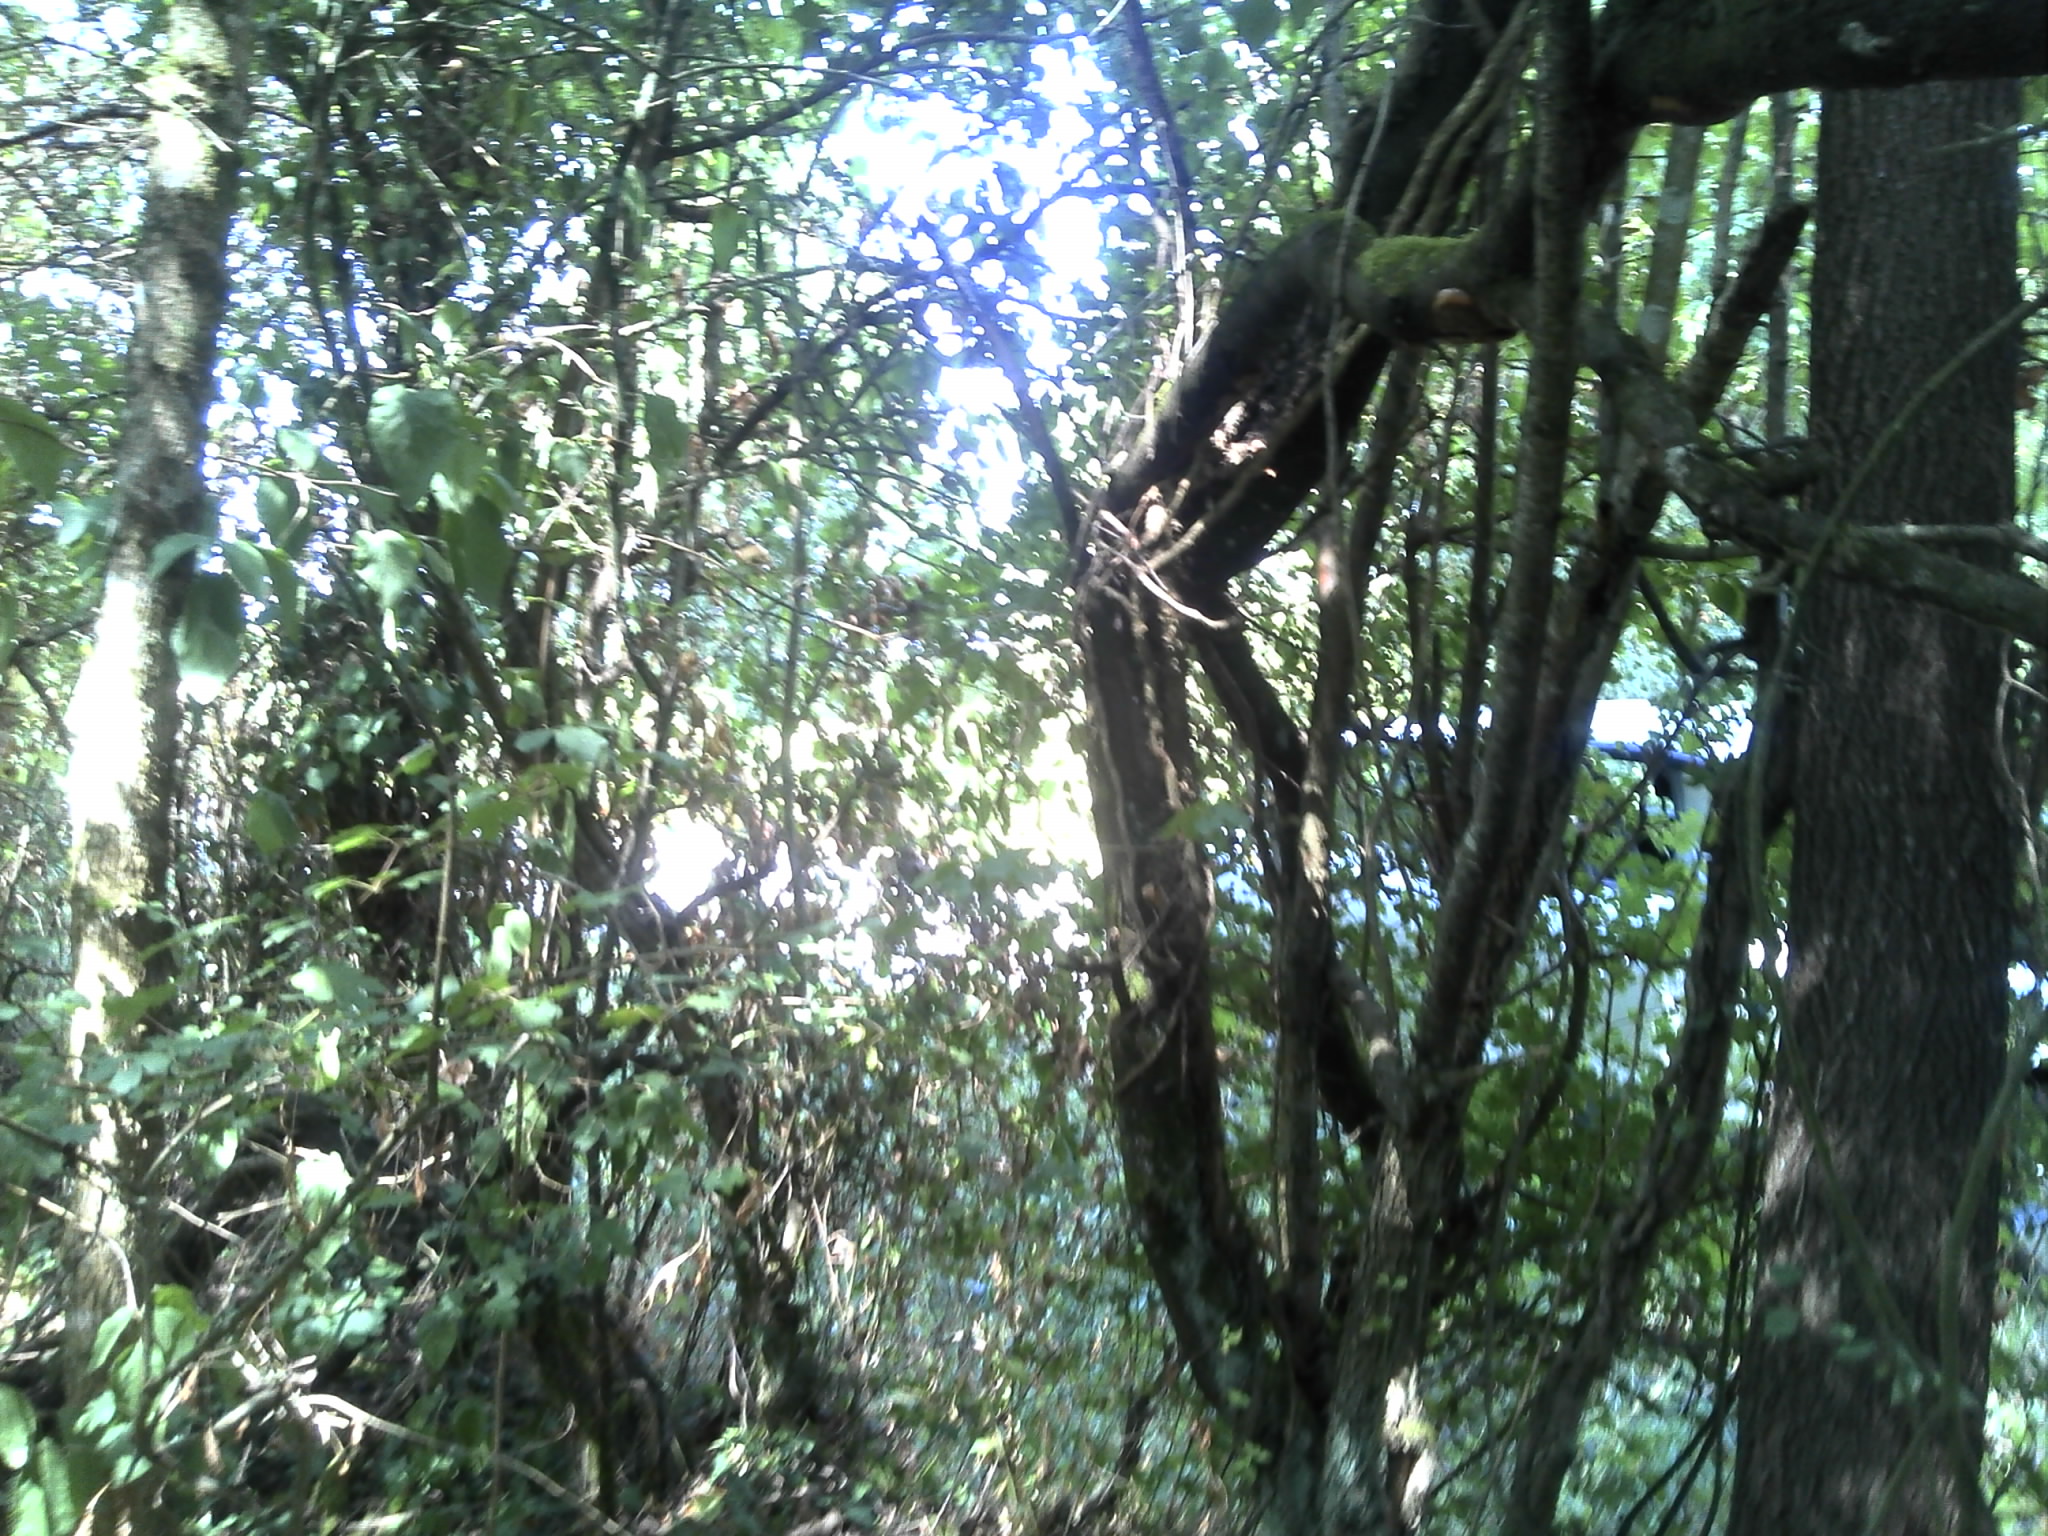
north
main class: Woodland
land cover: Broadleaved woodland
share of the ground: > 75 %
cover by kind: broadleaved forest trees 80 %, shrubs 15 %, herbaceous plants 5 %
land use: Semi-natural and natural areas not in use
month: August
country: FR
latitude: 46.5339
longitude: 1.6853
